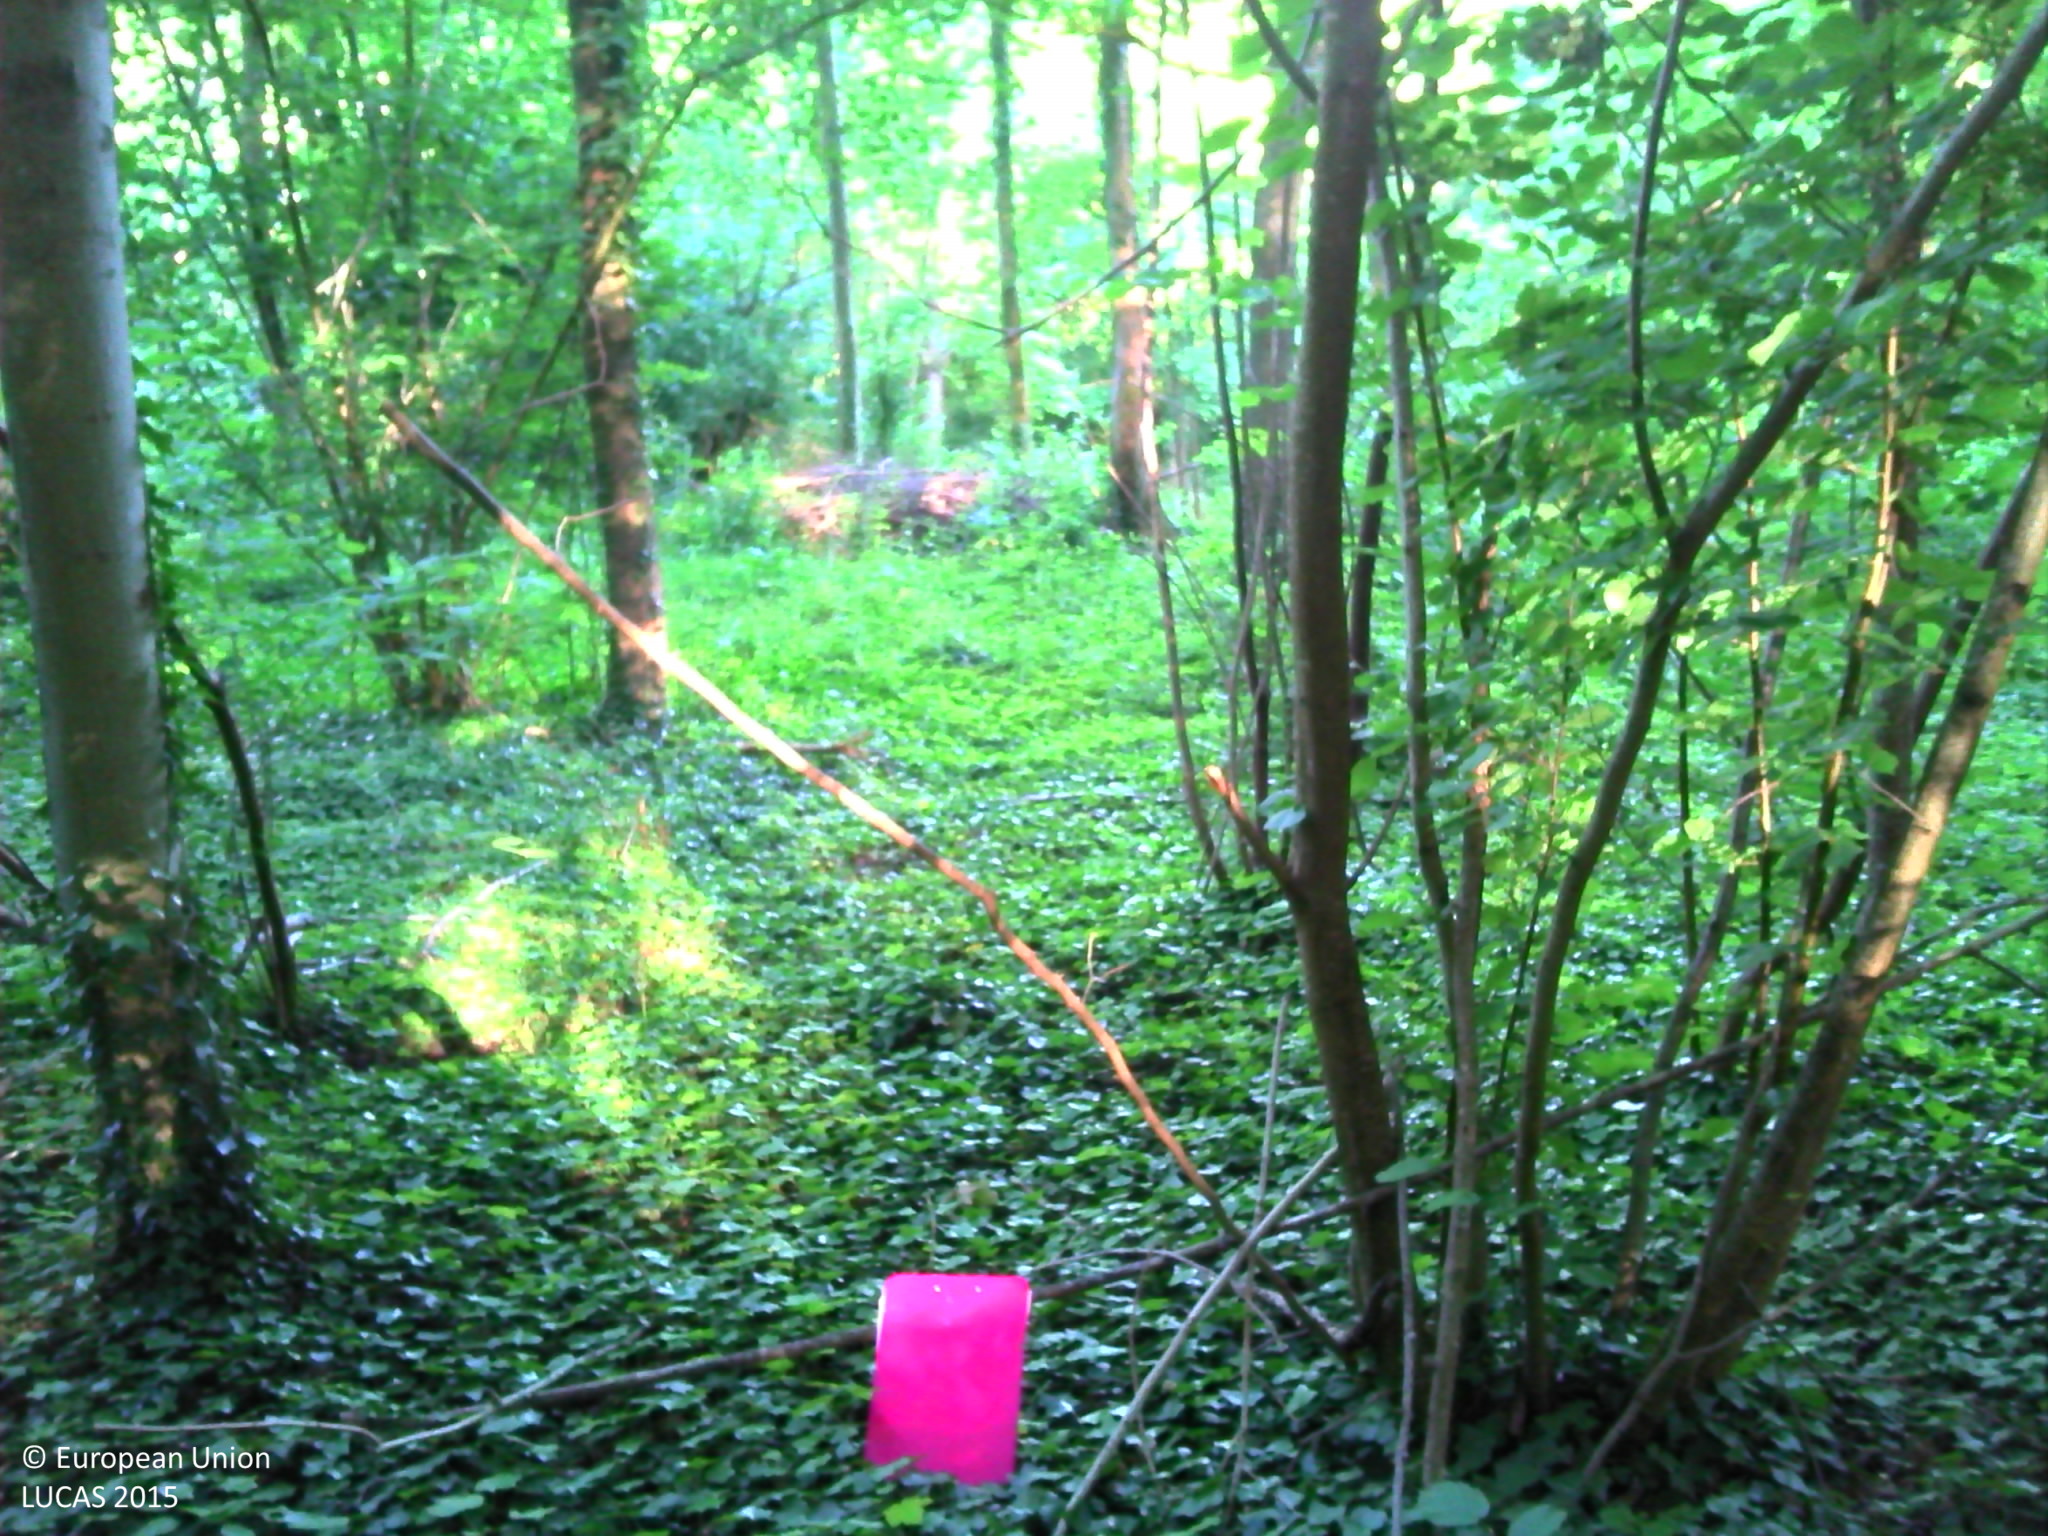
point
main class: Woodland
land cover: Broadleaved woodland
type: mesophytic deciduous forest
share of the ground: > 75 %
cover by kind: broadleaved forest trees 85 %, shrubs 10 %, herbaceous plants 5 %
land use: Forestry
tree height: > 5 m
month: June
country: FR
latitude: 49.2561
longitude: 2.8593
